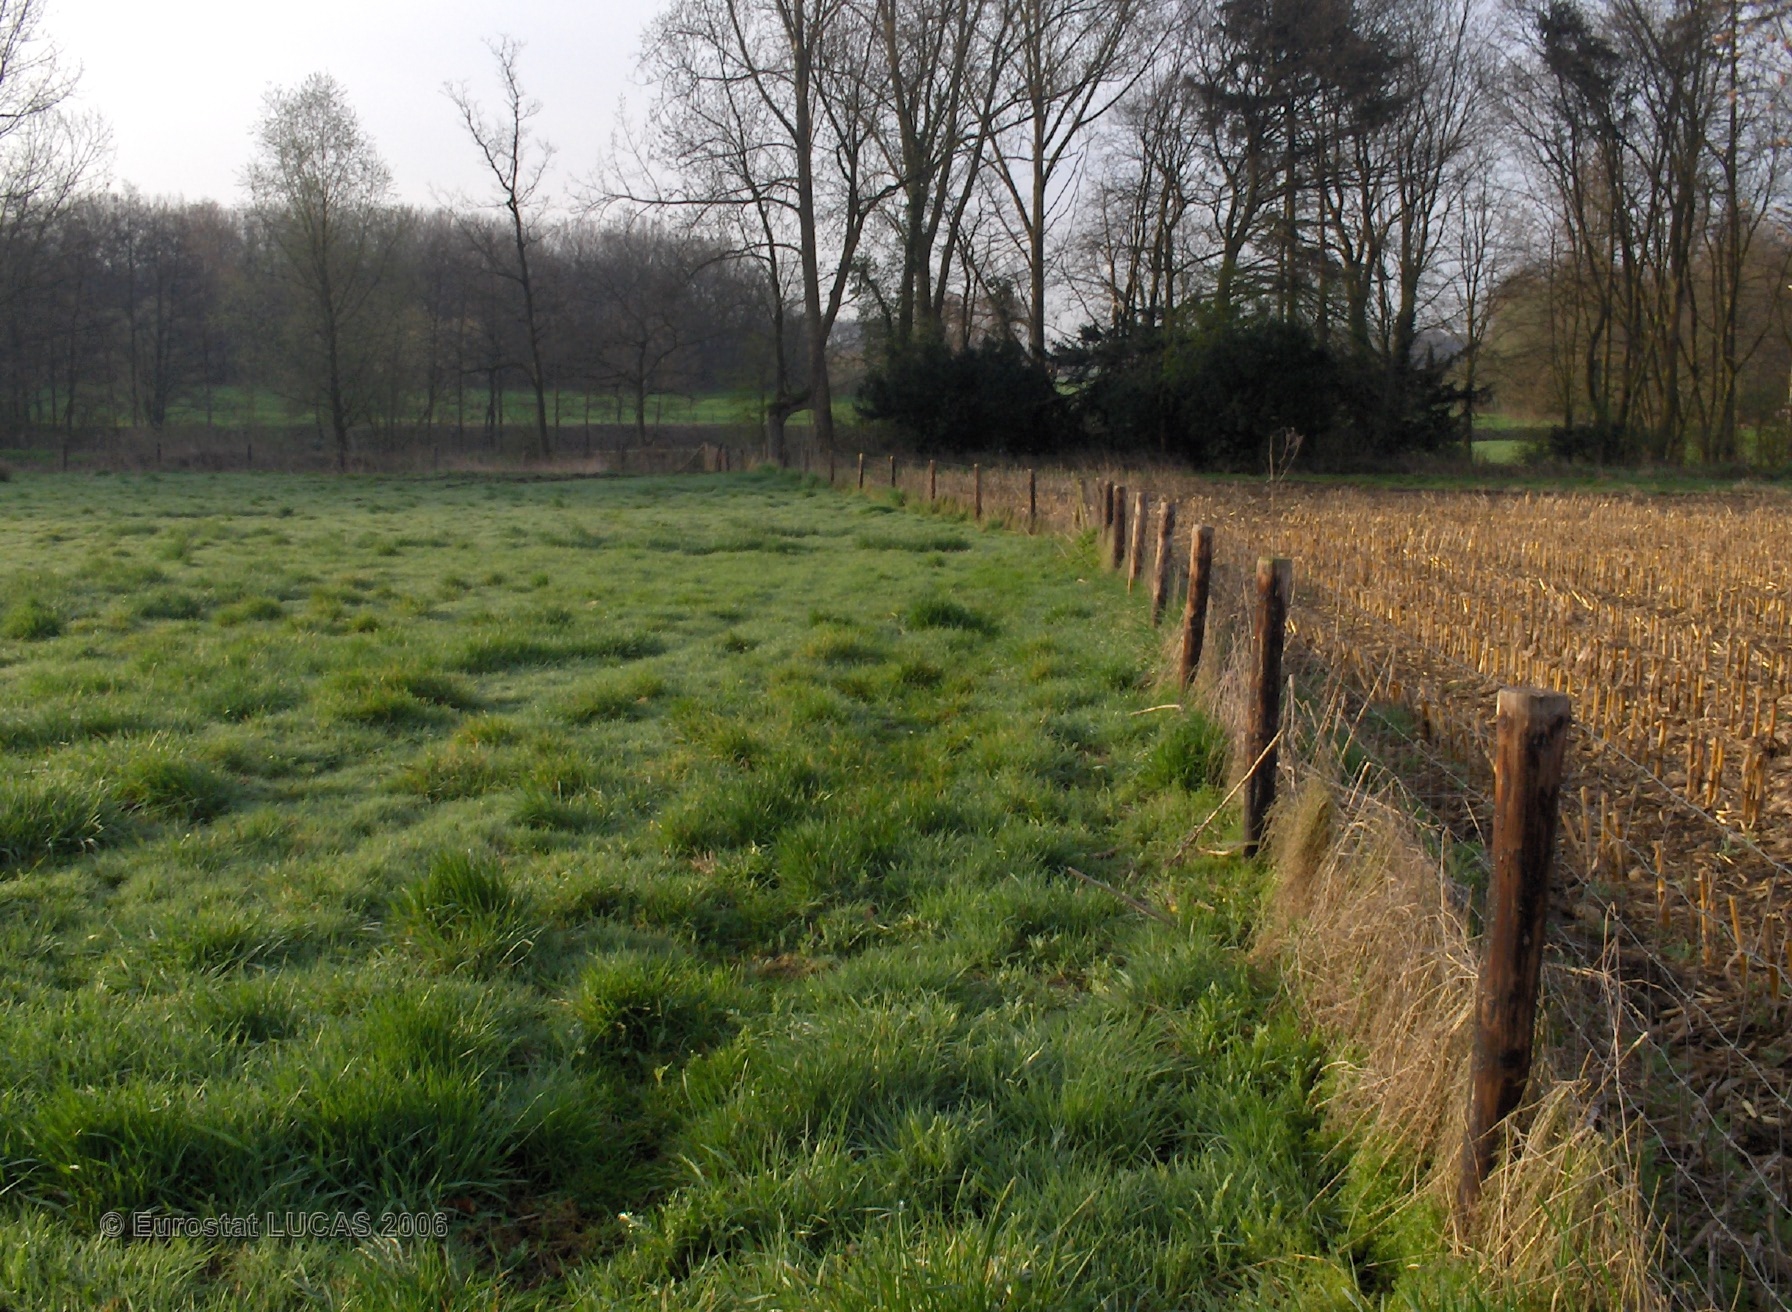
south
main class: Grassland
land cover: Grassland without tree/shrub cover
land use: Agriculture (excluding fallow land and kitchen gardens)
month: April
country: BE
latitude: 50.8582
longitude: 5.2100
